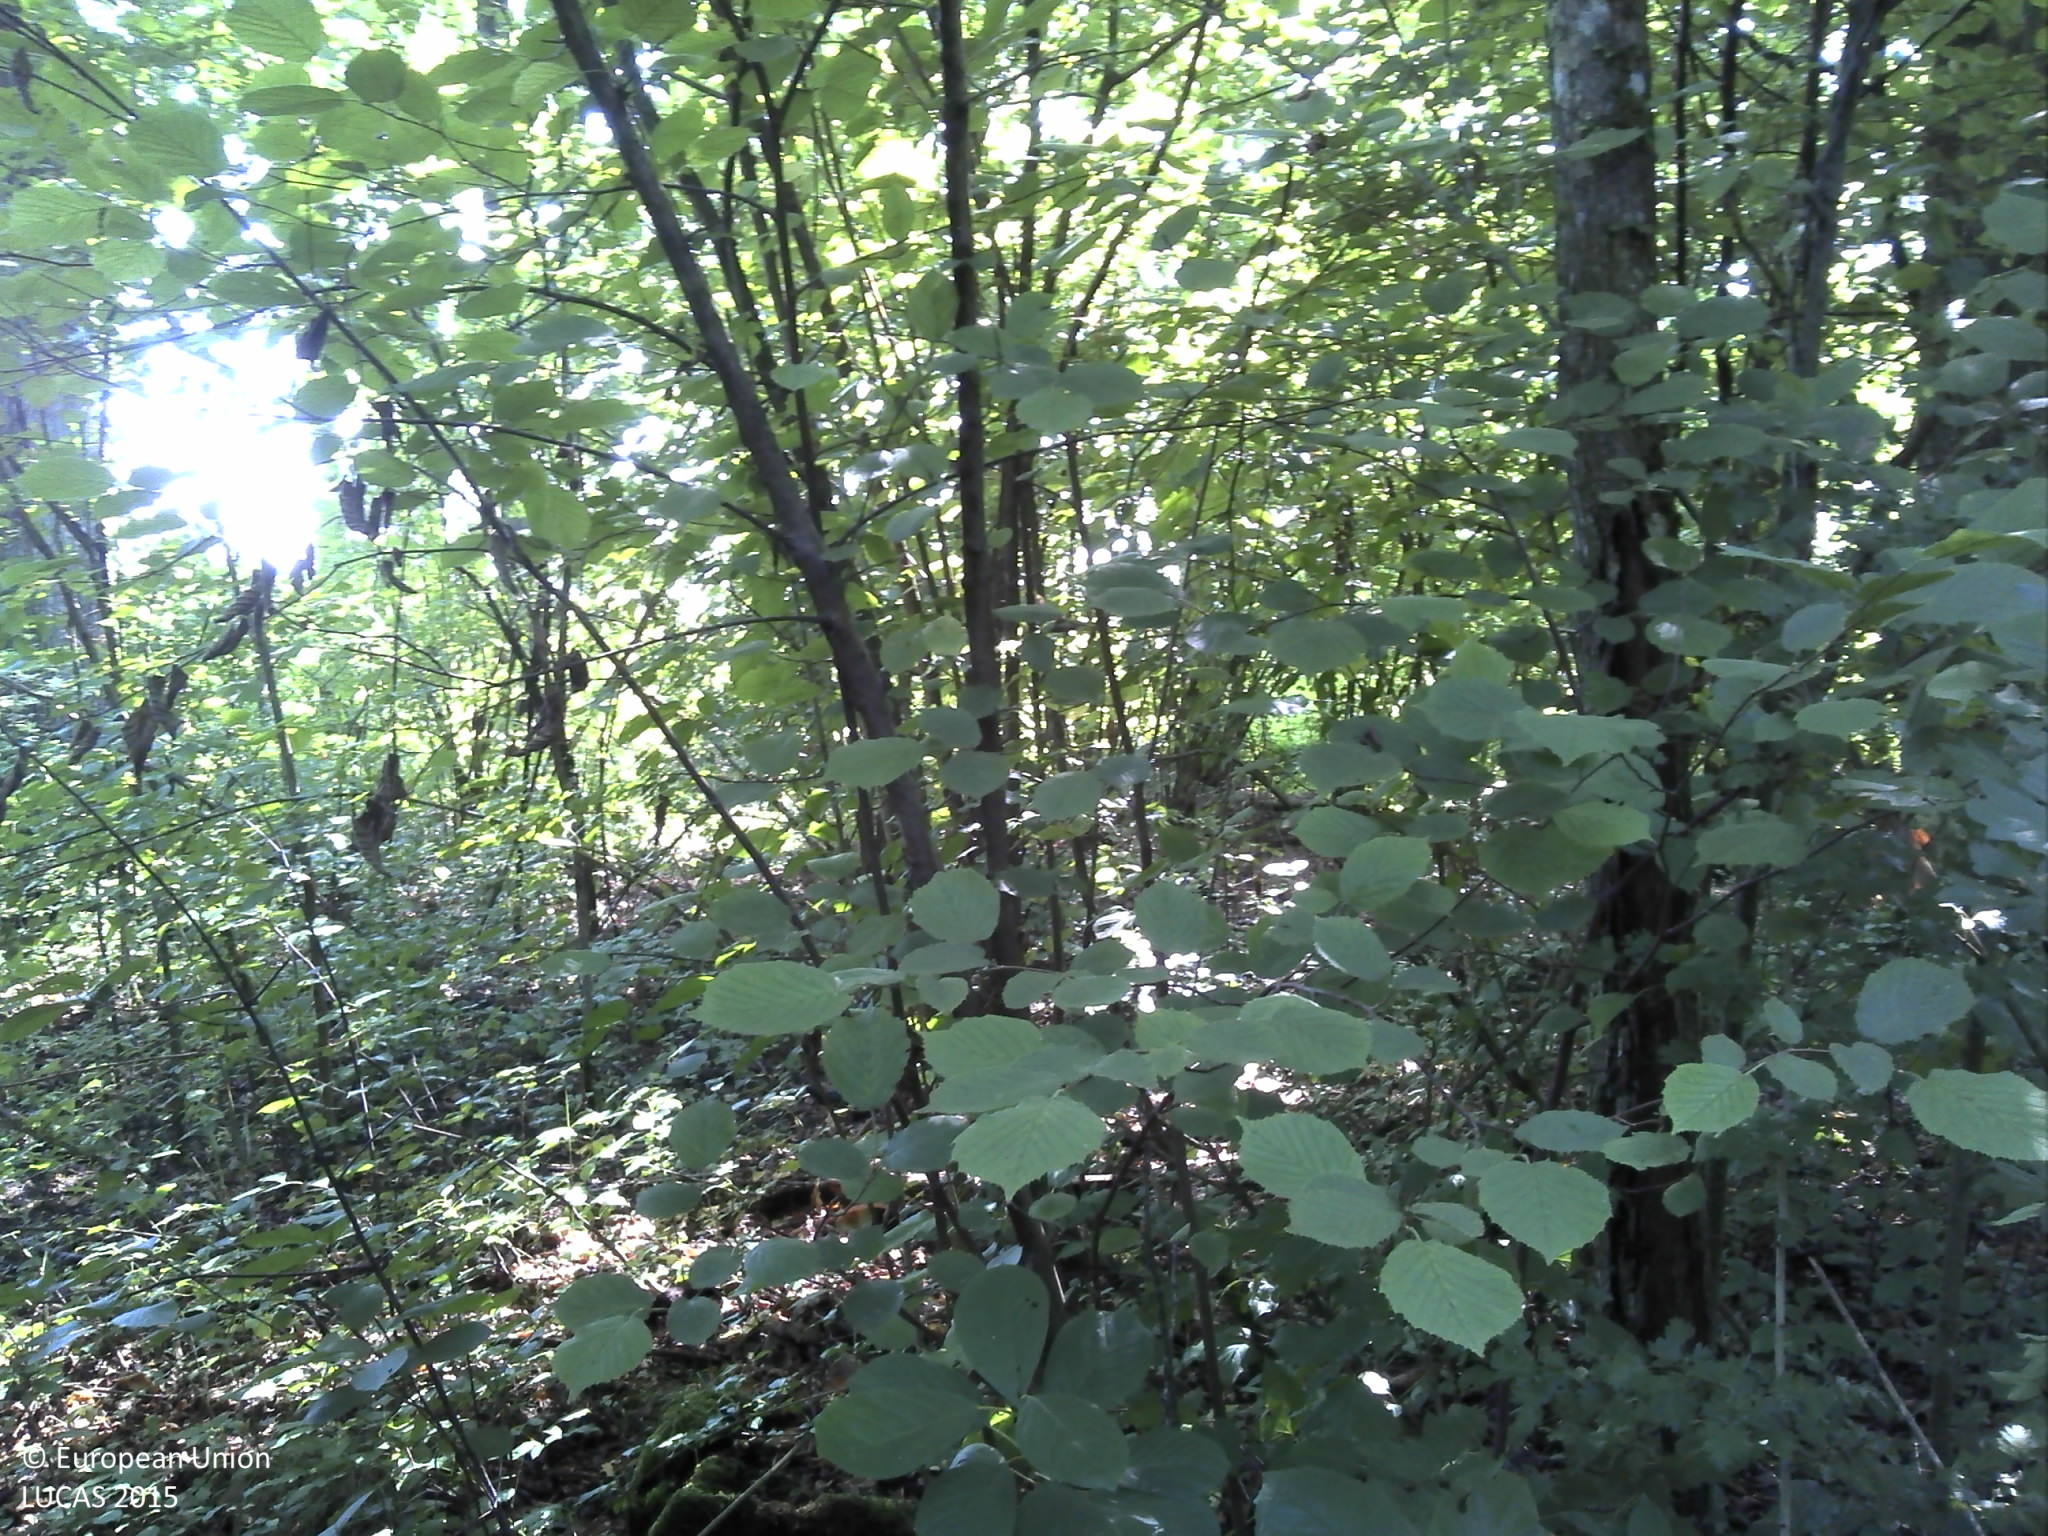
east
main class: Woodland
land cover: Broadleaved woodland
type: acidophilous oak and oak-birch forest
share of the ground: > 75 %
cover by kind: broadleaved forest trees 80 %, lichens and mosses 20 %
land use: Forestry
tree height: > 5 m
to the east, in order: Broadleaved woodland; Shrubland with sparse tree cover
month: August
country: HR
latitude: 45.5739
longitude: 16.5210
